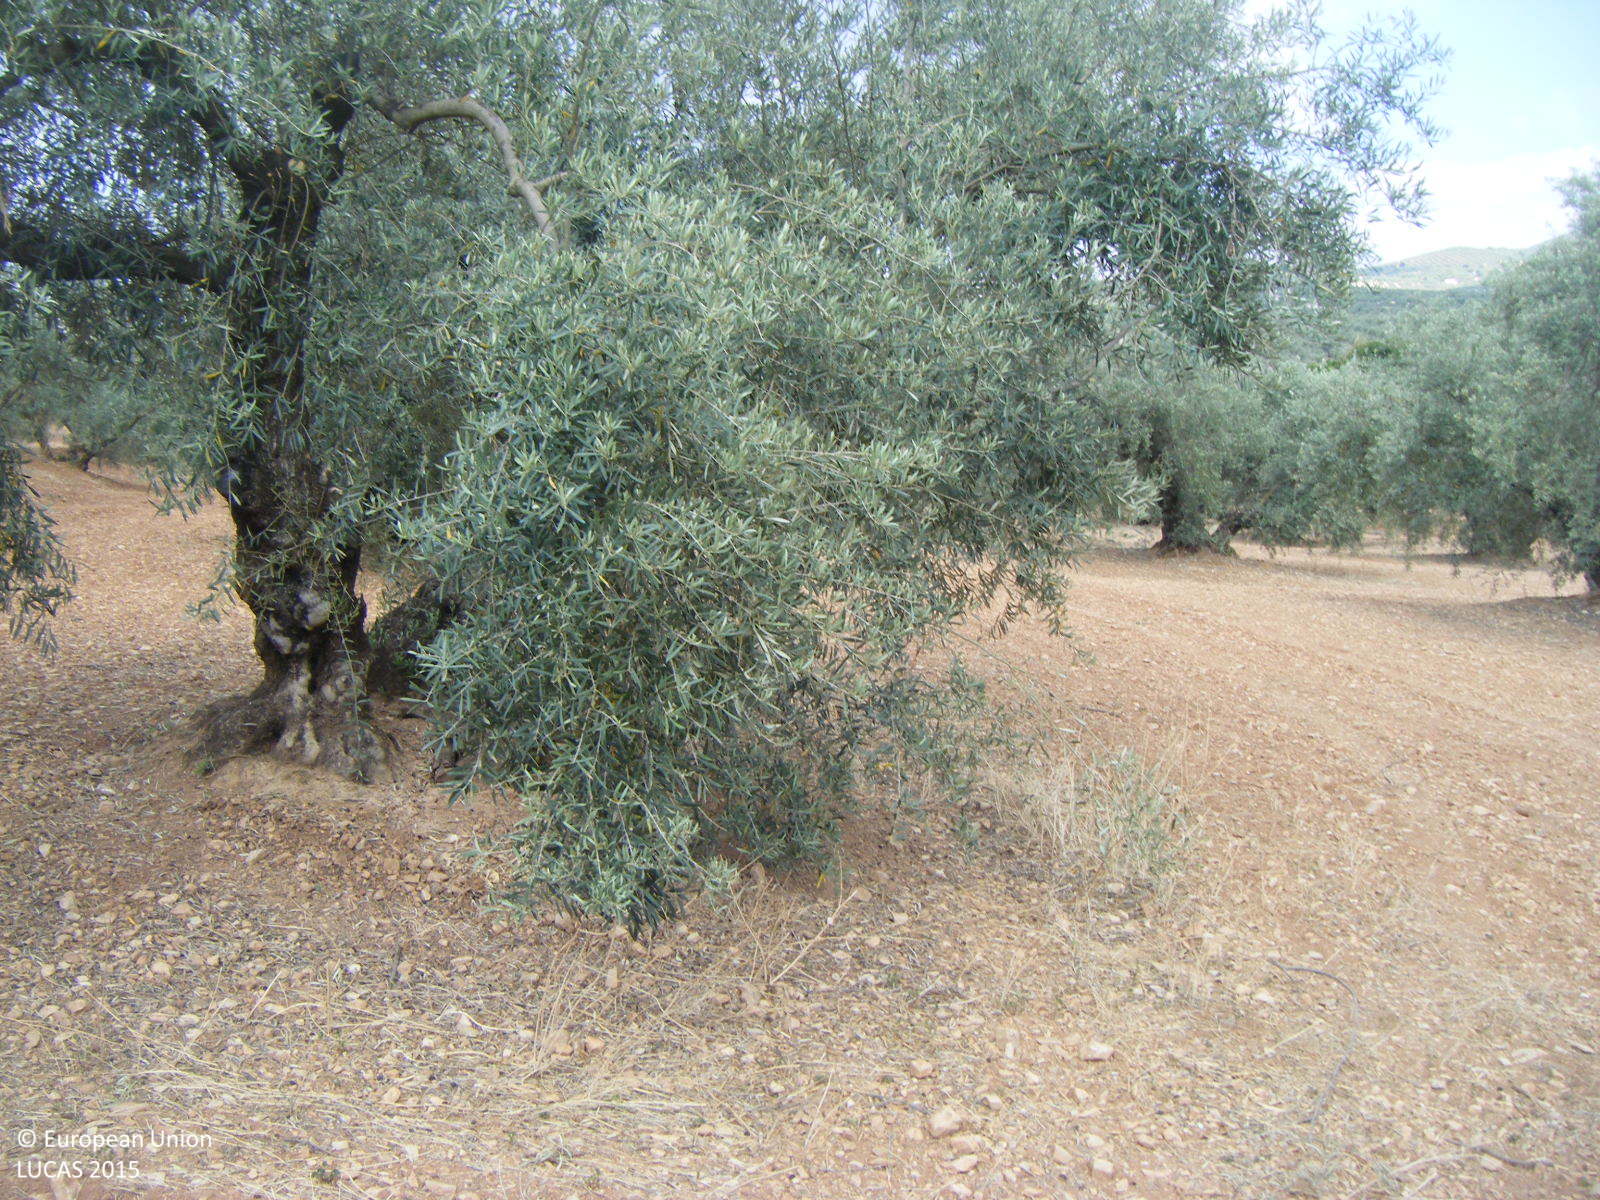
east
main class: Cropland
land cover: Olive groves
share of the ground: 25 - 50 %
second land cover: Other bare soil
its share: > 75 %
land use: Agriculture (excluding fallow land and kitchen gardens)
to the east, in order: Olive groves; Other bare soil
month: May
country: ES
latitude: 37.1924
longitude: -4.4293
